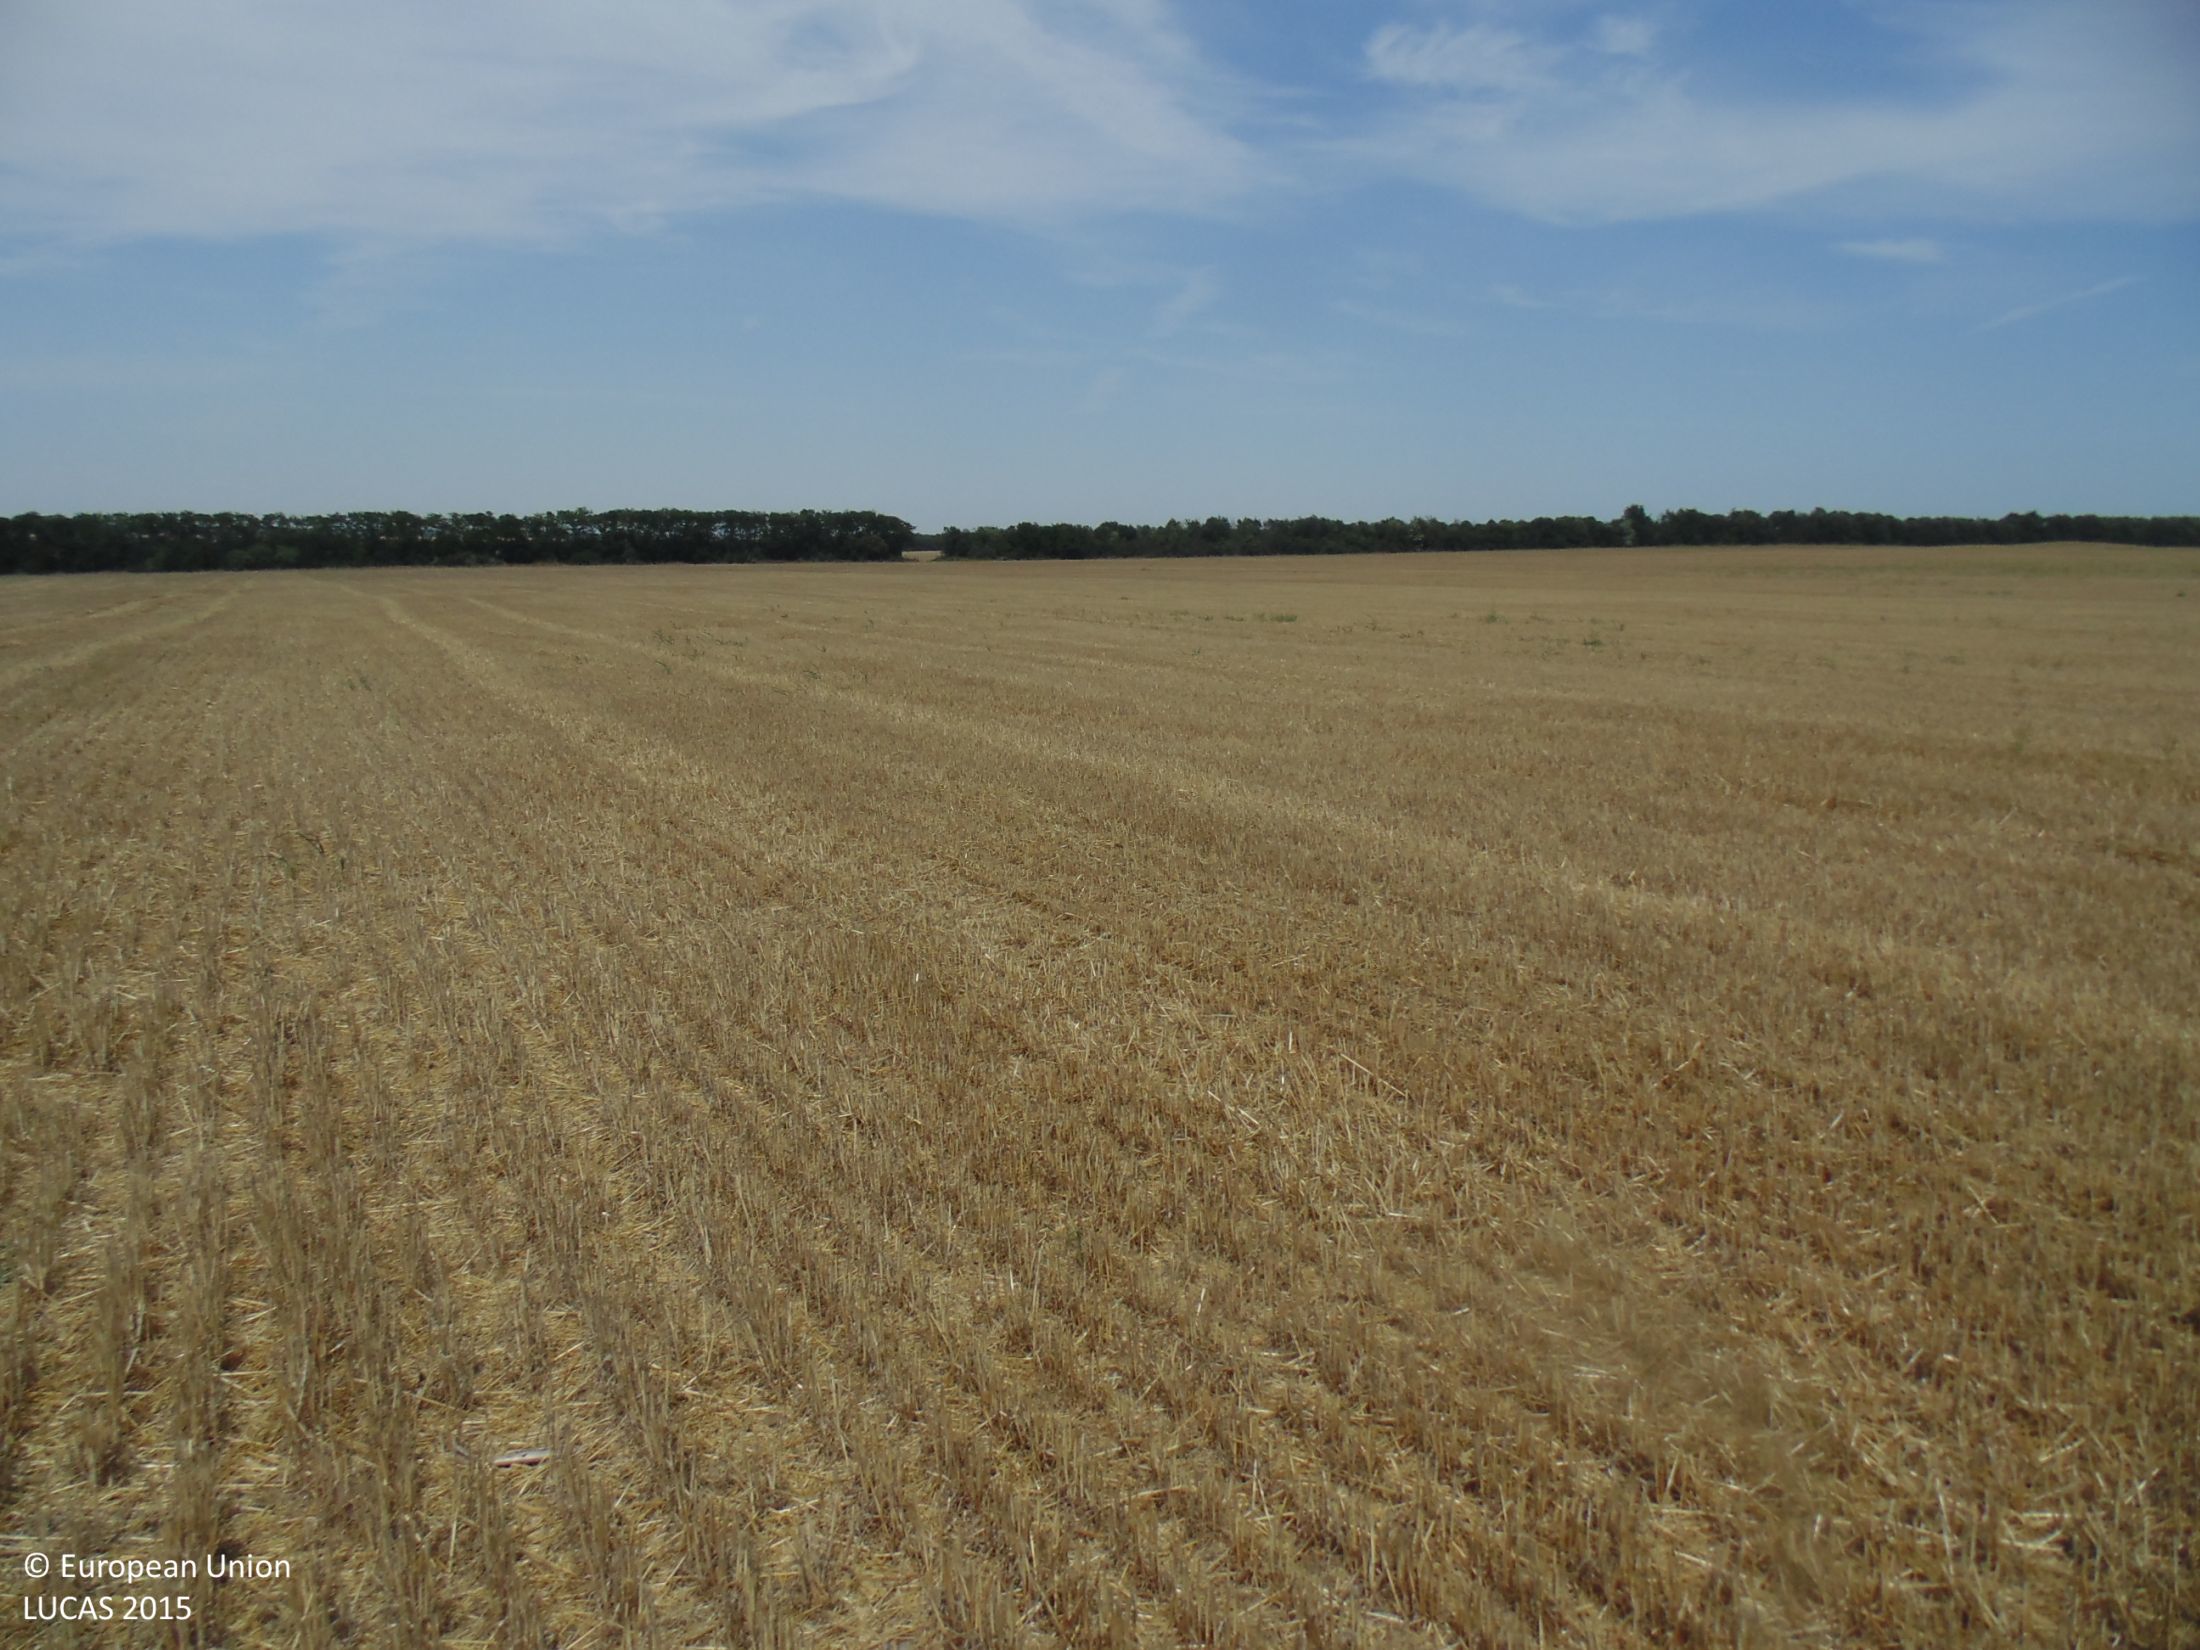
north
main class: Cropland
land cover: Common wheat
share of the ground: 25 - 50 %
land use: Agriculture (excluding fallow land and kitchen gardens)
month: August
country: BG
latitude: 43.6262
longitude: 28.5178
